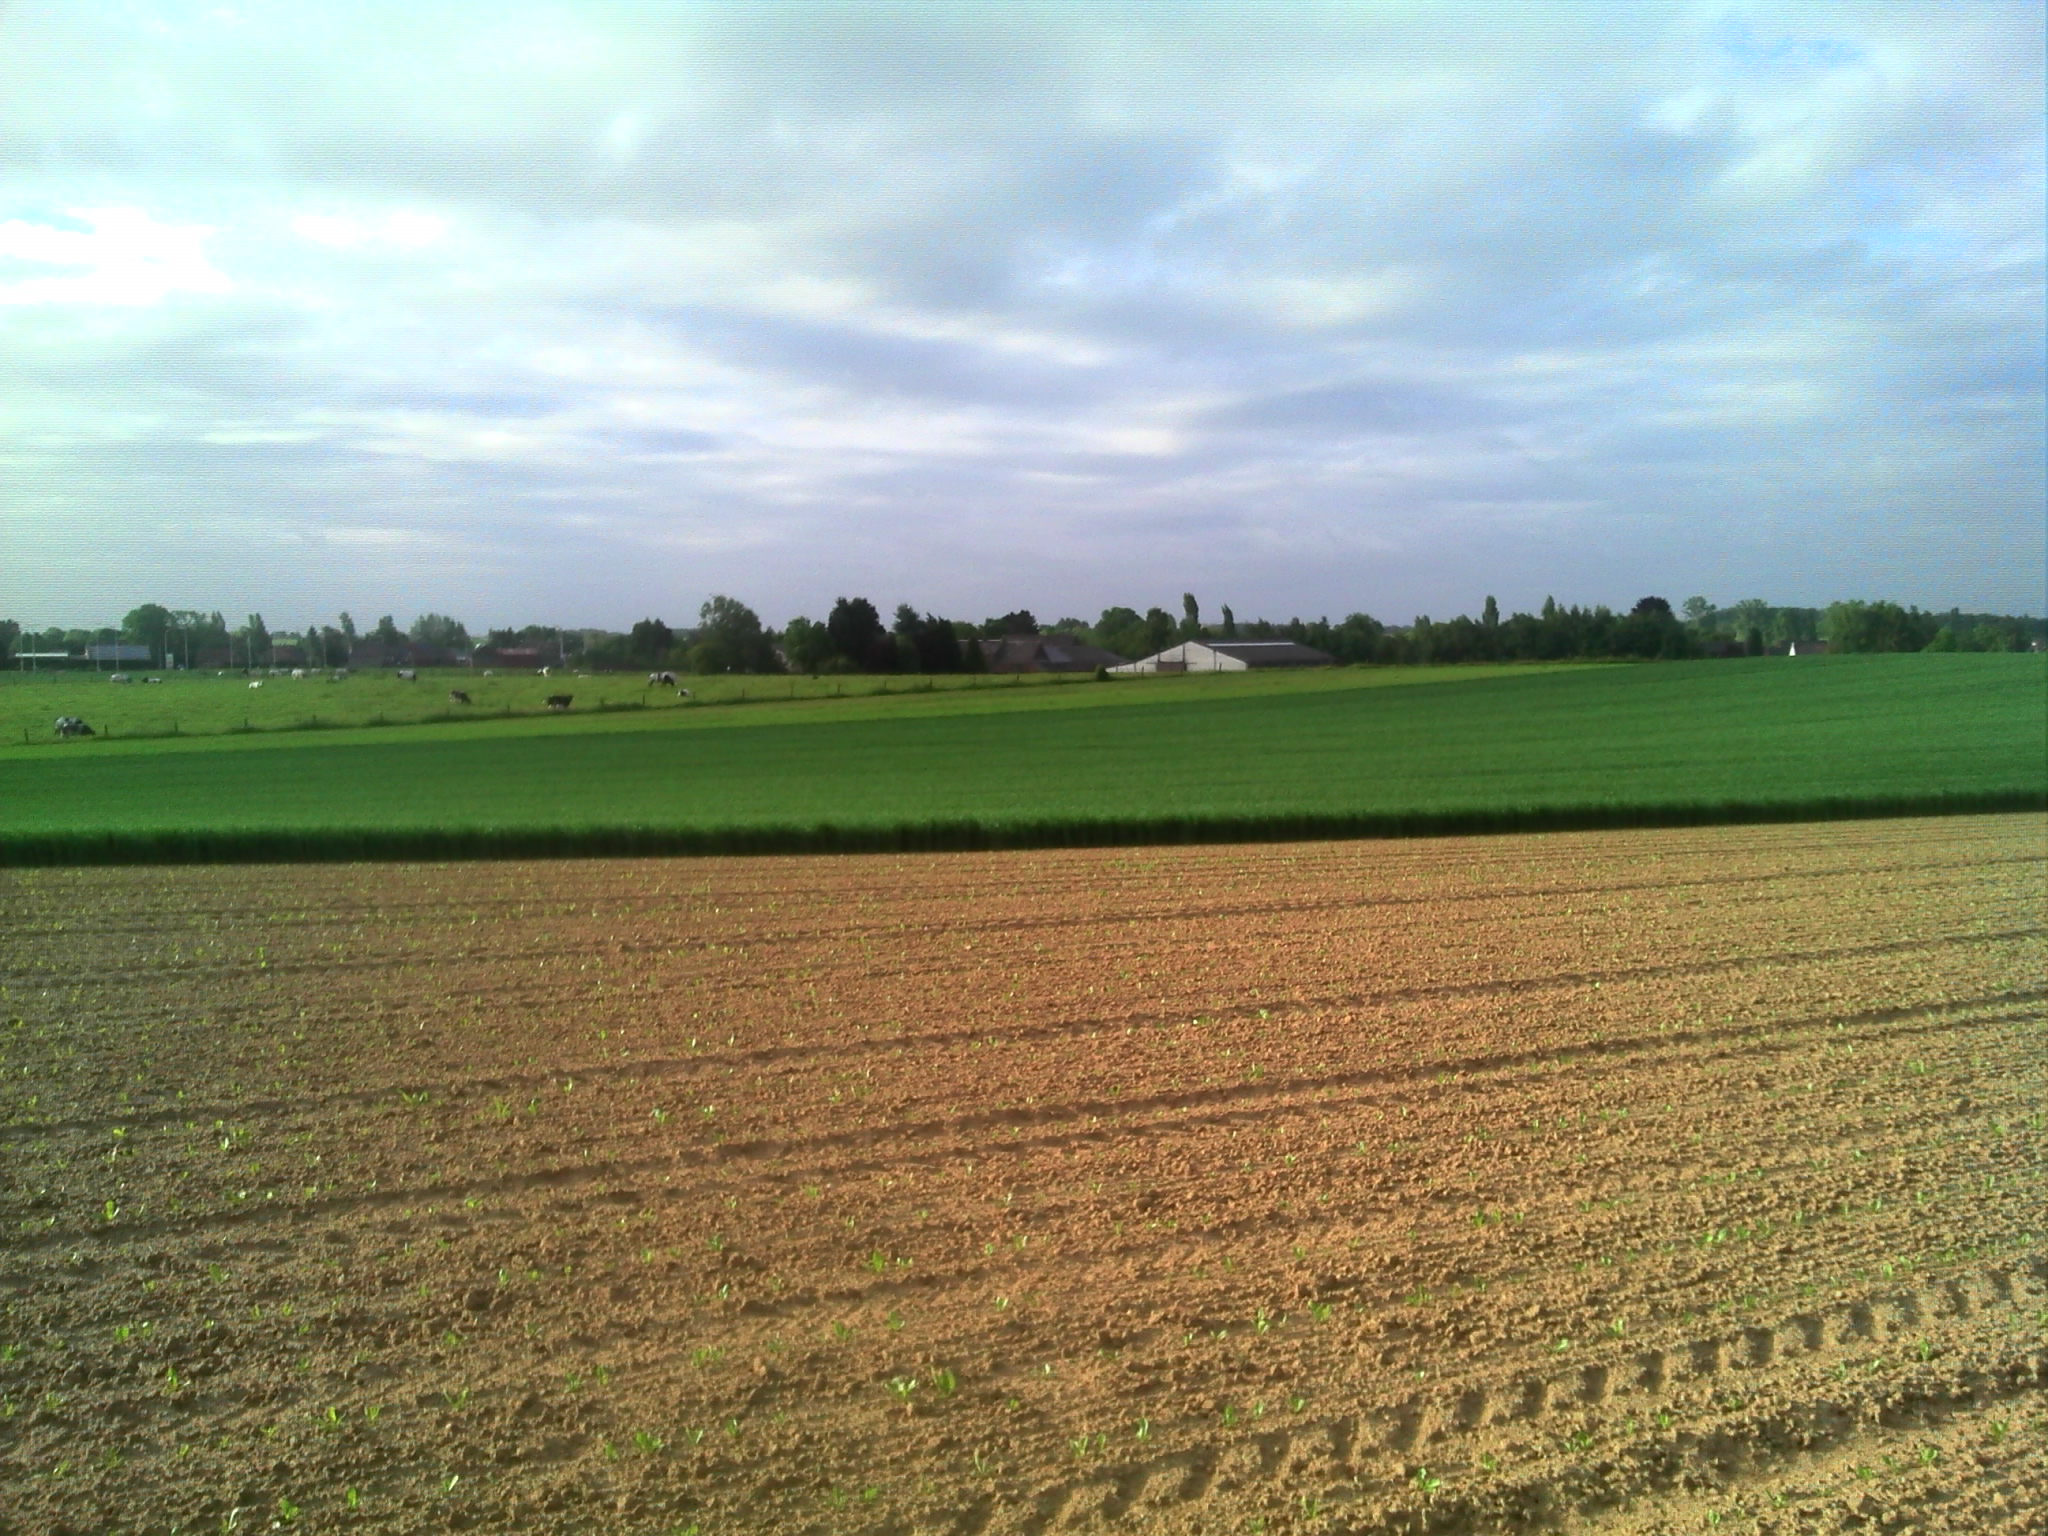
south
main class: Cropland
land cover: Other non-permanent industrial crops
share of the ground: < 10 %
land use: Agriculture (excluding fallow land and kitchen gardens)
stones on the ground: < 10 %
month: June
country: BE
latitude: 50.6002
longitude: 4.6699
